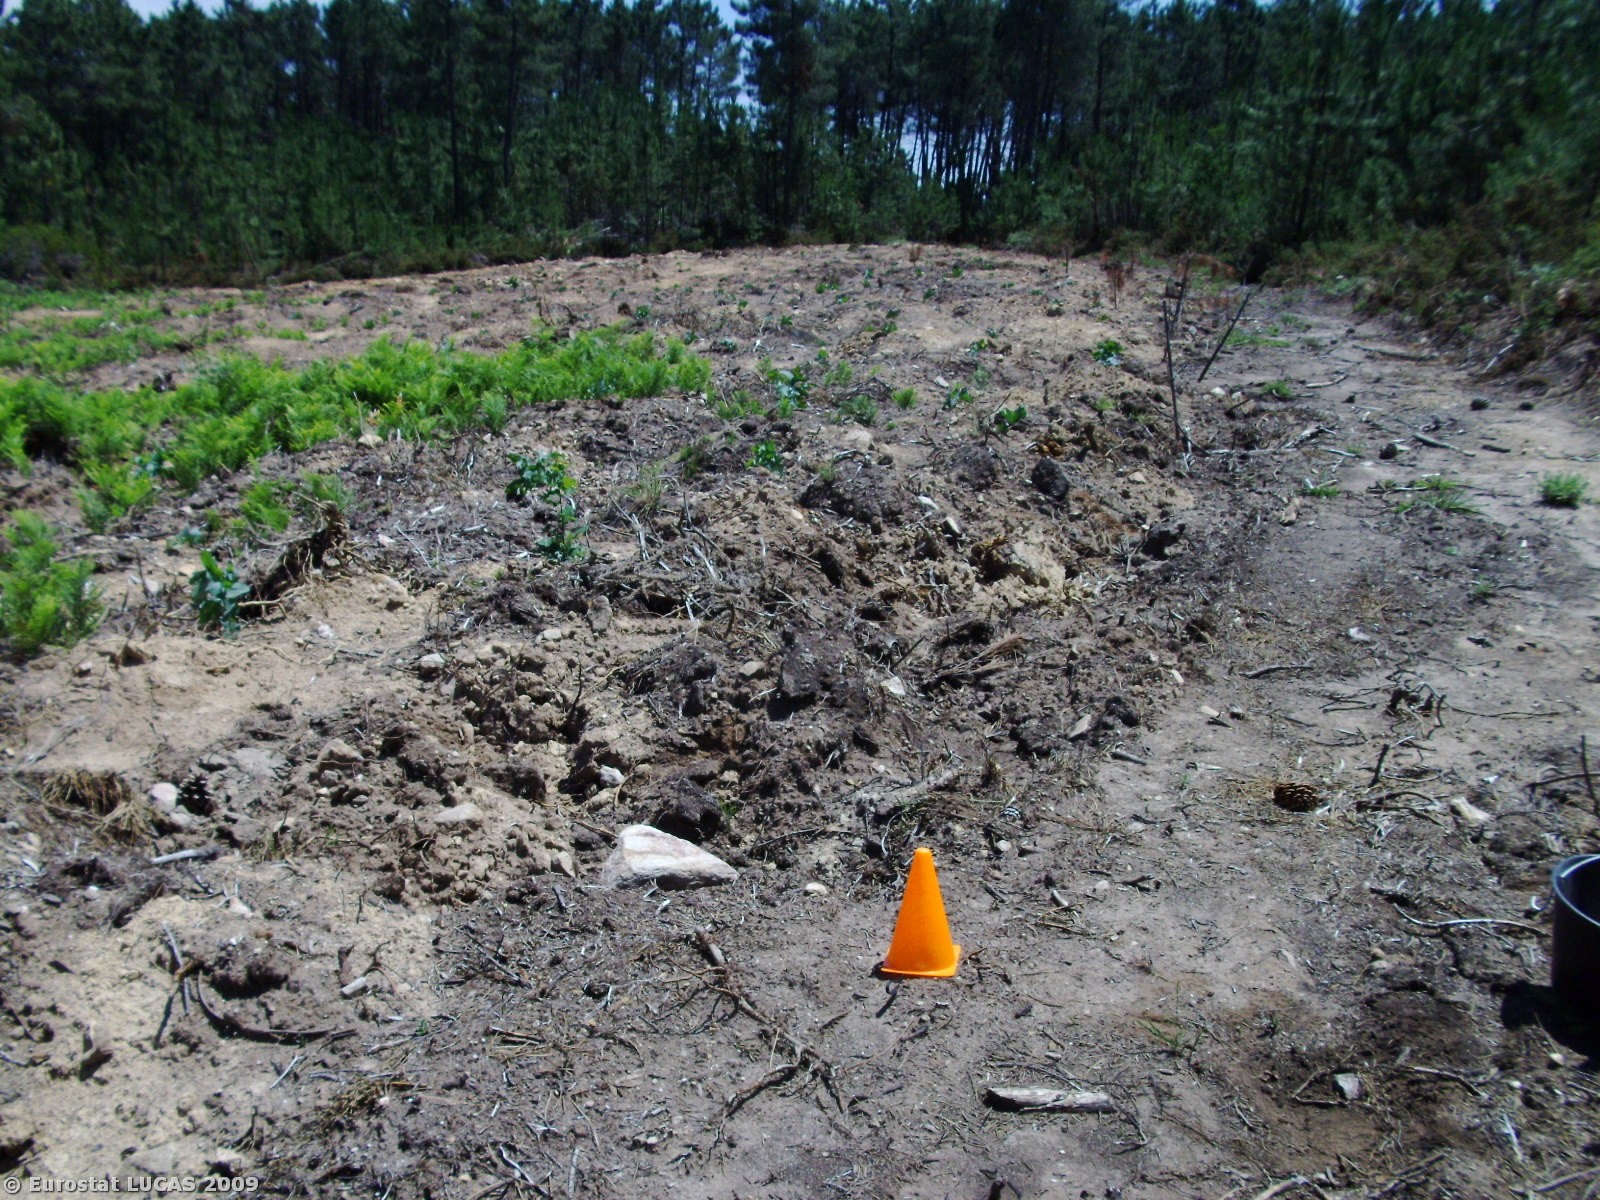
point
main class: Woodland
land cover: Broadleaved woodland
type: mesophytic deciduous forest
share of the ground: 25 - 50 %
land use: Forestry
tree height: > 5 m
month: July
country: PT
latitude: 40.8956
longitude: -7.7019
